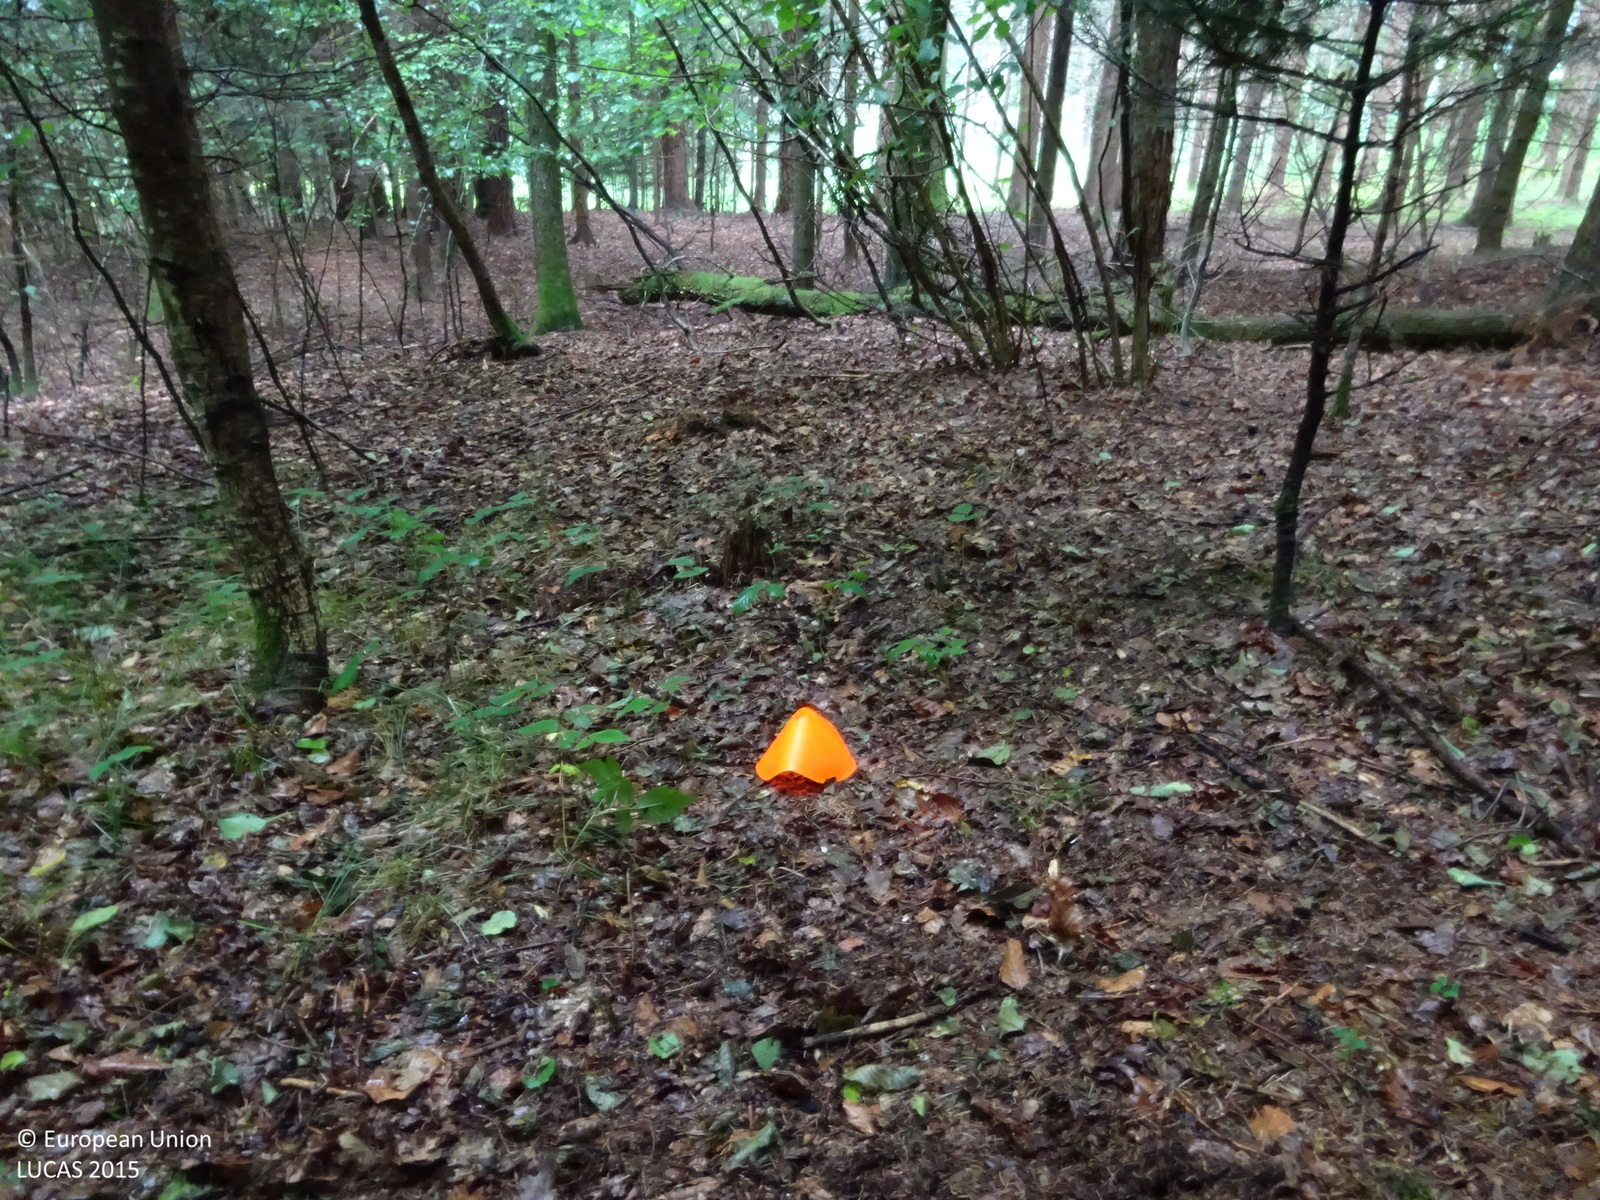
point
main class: Woodland
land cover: Spruce dominated mixed woodland
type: mountainous beech forest
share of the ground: > 75 %
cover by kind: coniferous forest trees 40 %, broadleaved forest trees 40 %, shrubs 20 %
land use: Forestry
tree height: > 5 m
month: July
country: AT
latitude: 46.8343
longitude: 15.2827
